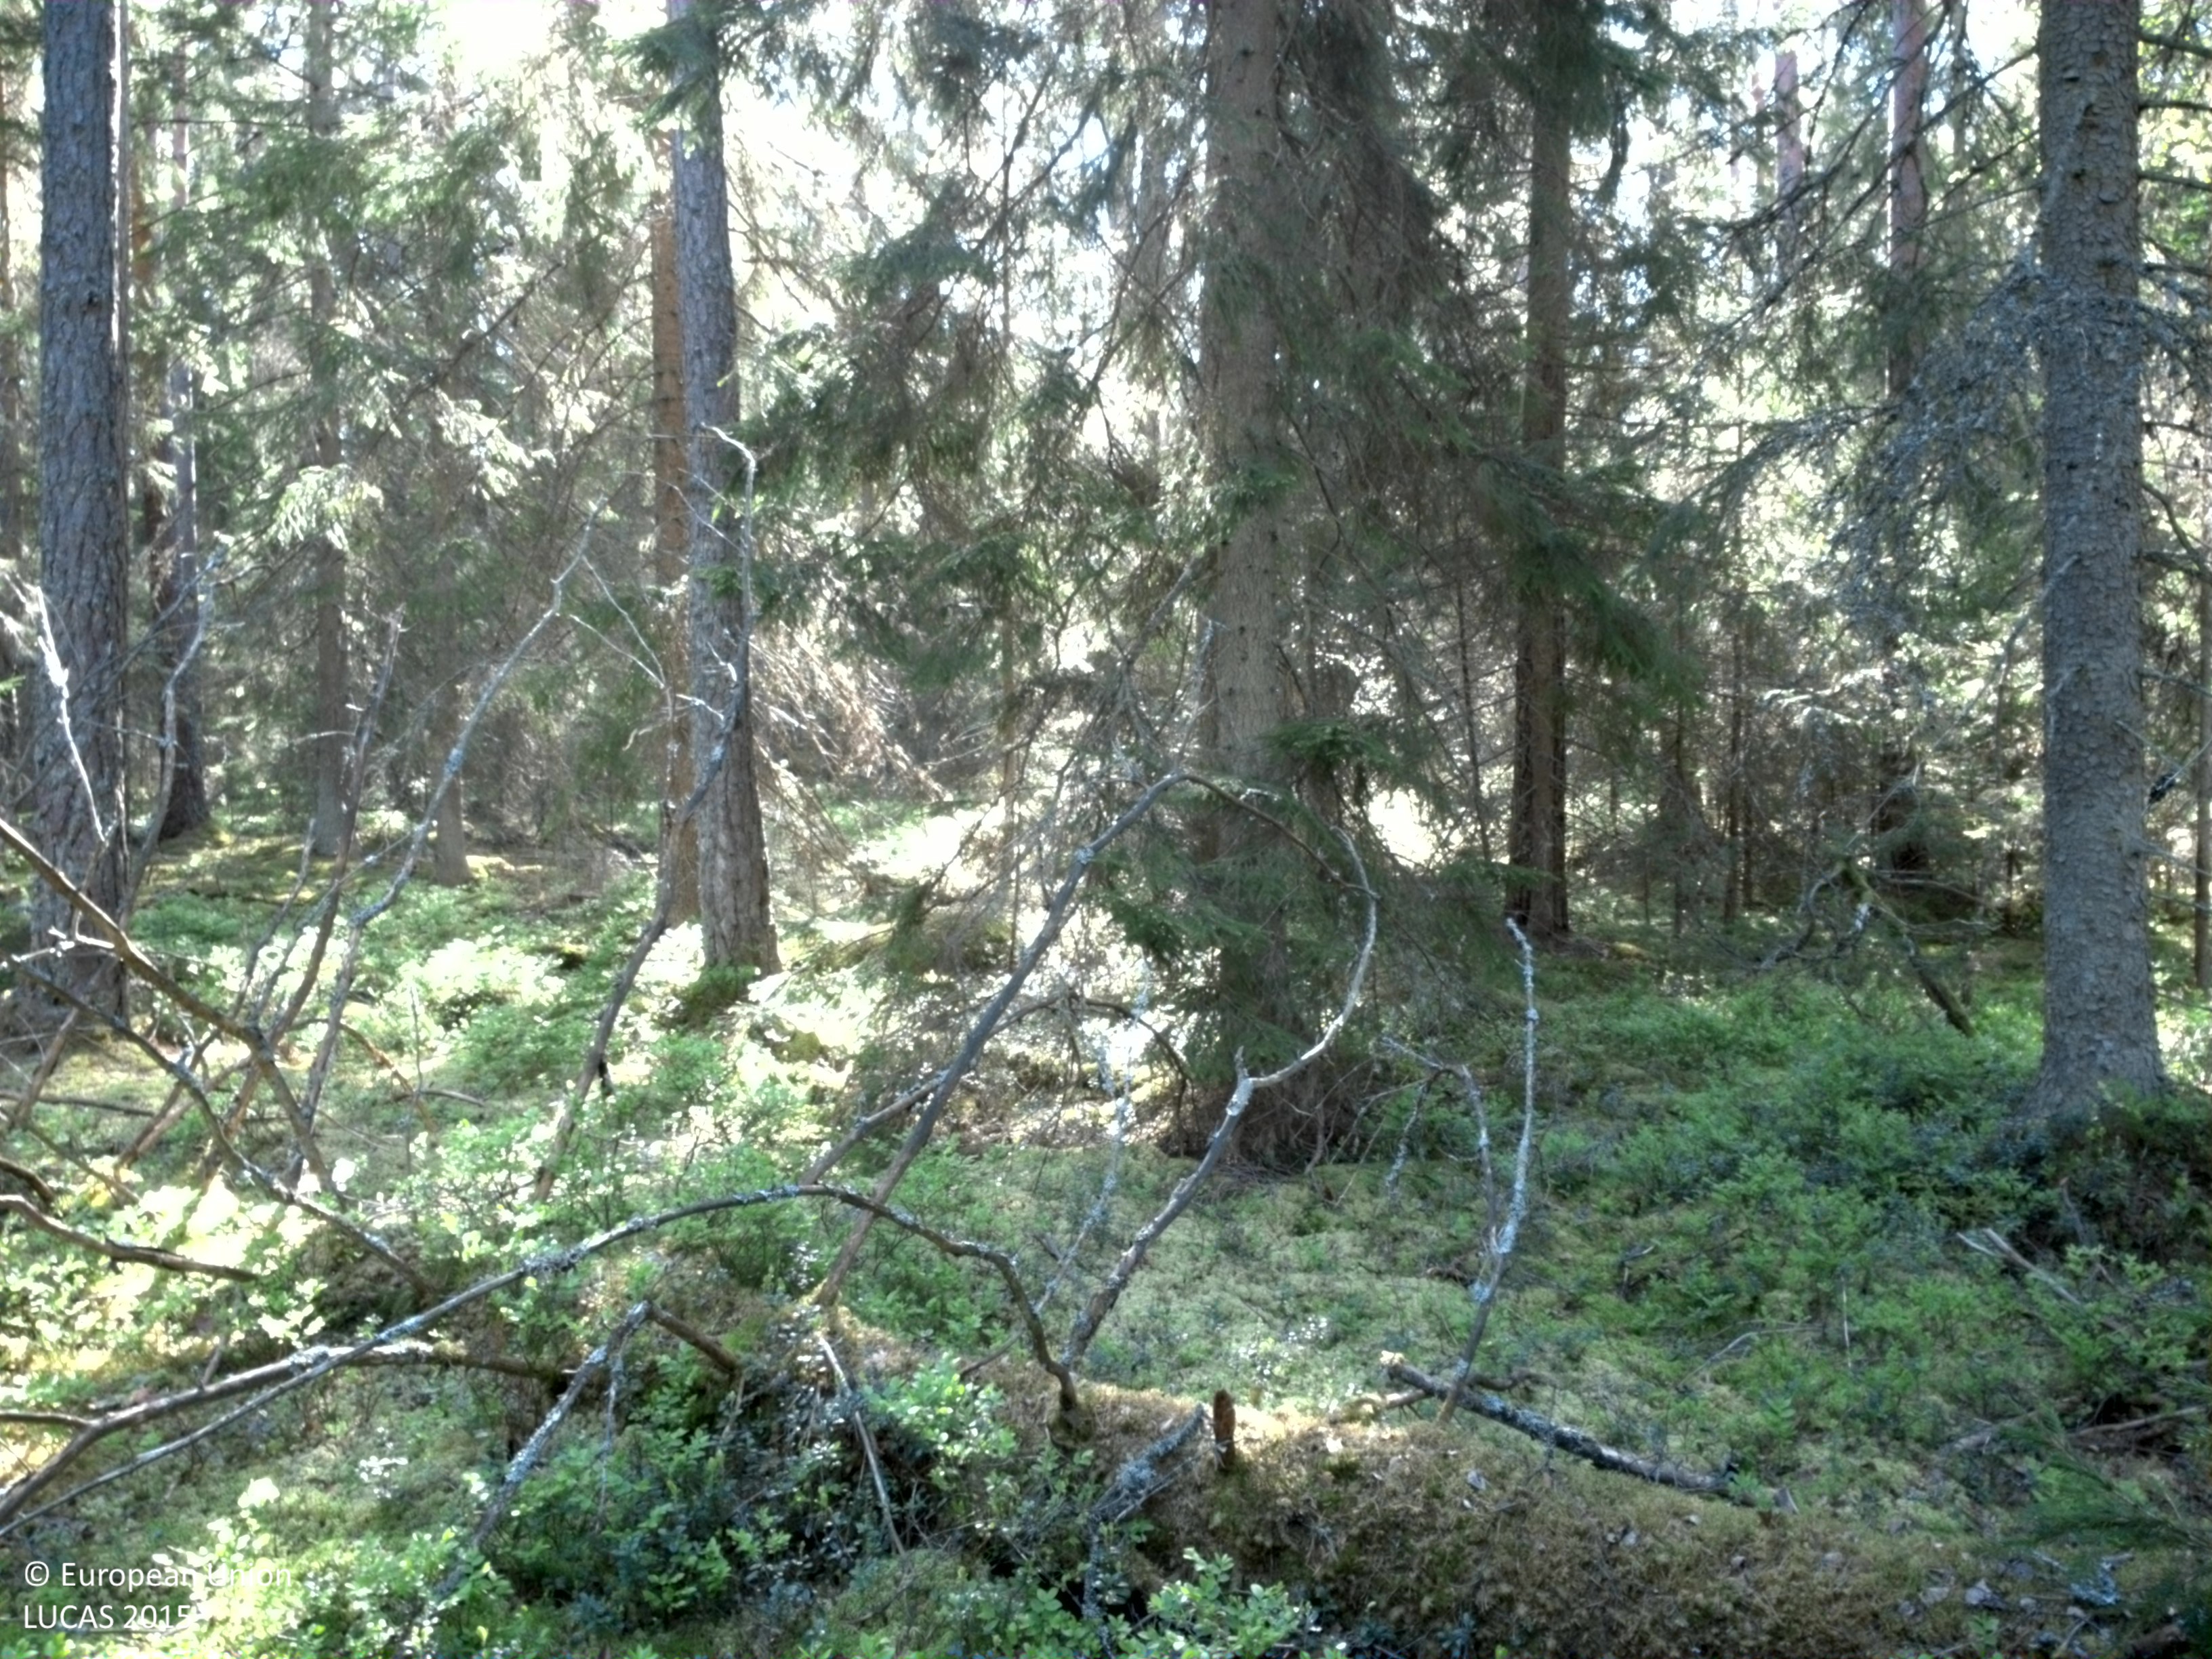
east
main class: Woodland
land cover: Spruce dominated coniferous woodland
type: boreal forest
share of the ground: 50 - 75 %
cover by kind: coniferous forest trees 40 %, shrubs 30 %, lichens and mosses 20 %, broadleaved forest trees 10 %
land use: Forestry
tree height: > 5 m
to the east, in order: Spruce dominated coniferous woodland; Pine dominated coniferous woodland; Spruce dominated coniferous woodland; Spruce dominated mixed woodland; Tracks; Spruce dominated coniferous woodland
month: May
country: SE
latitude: 57.3849
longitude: 15.9366
